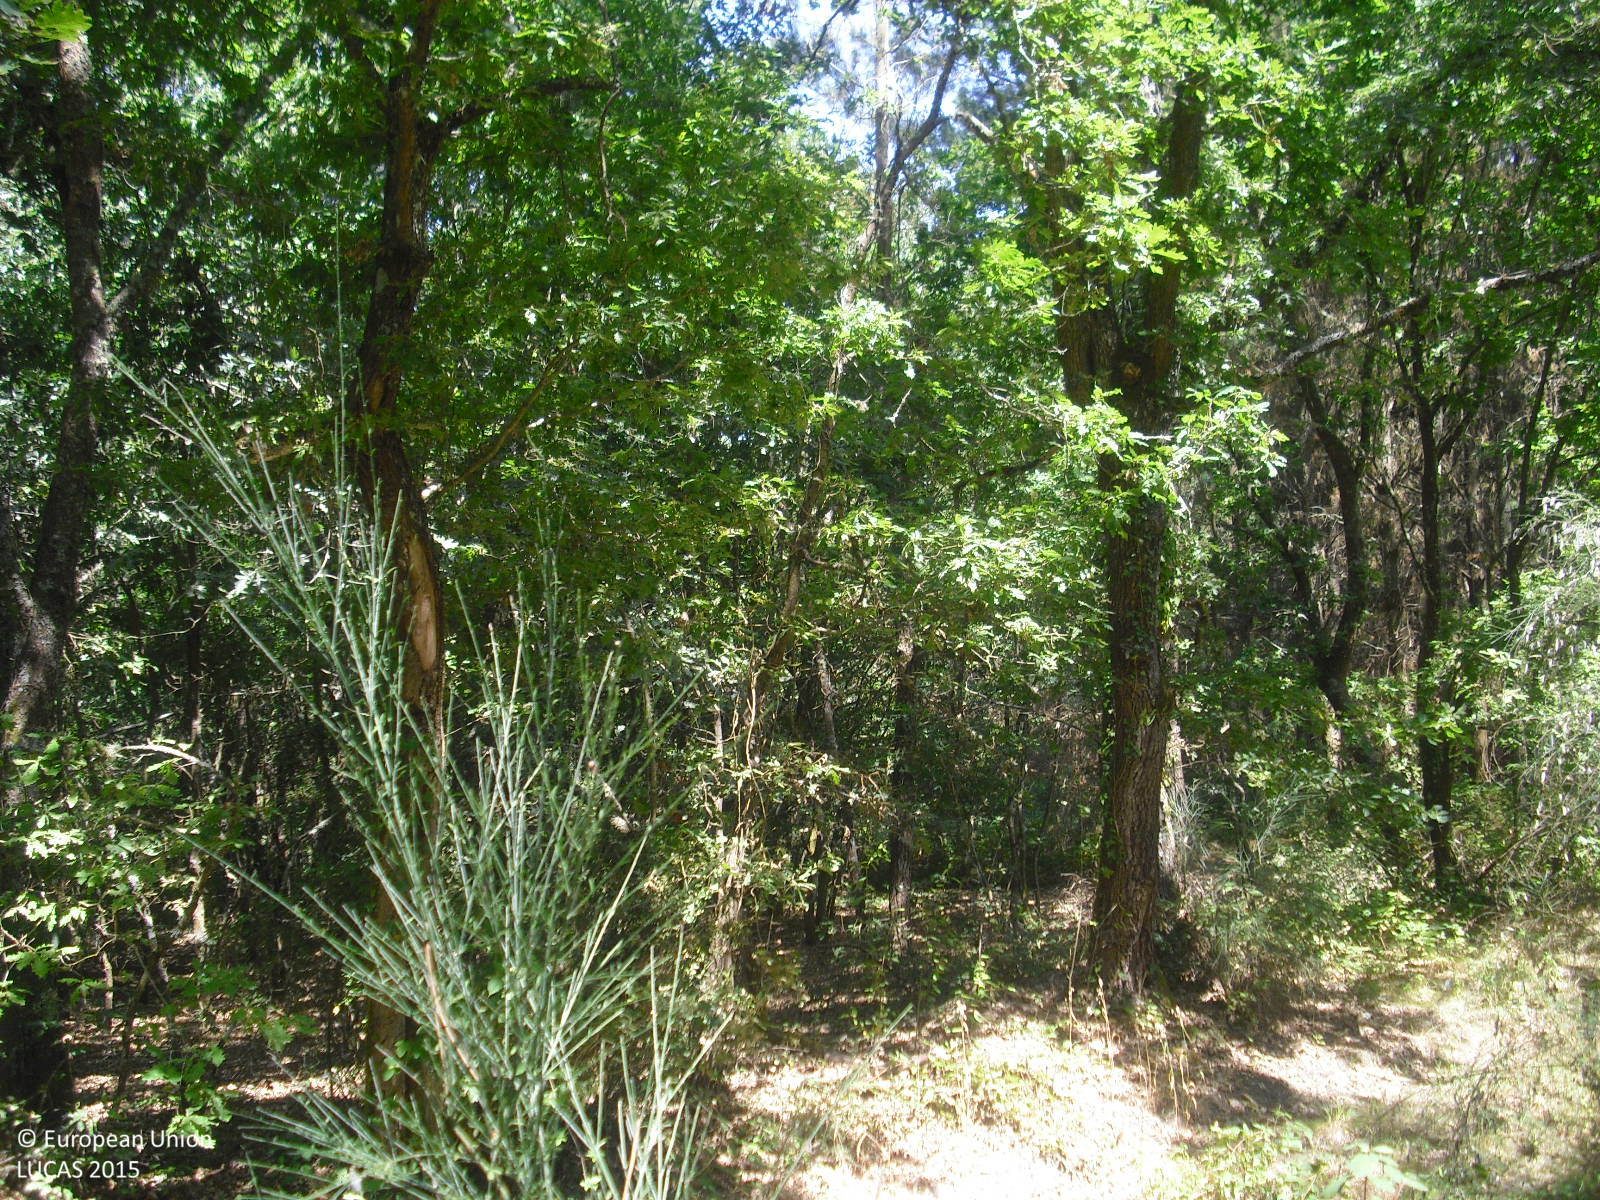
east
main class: Woodland
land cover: Pine dominated mixed woodland
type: hemiboreal forest and nemoral coniferous forest and mixed broadleaved-coniferous forest
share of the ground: 50 - 75 %
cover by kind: coniferous forest trees 45 %, broadleaved forest trees 35 %, shrubs 20 %
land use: Forestry
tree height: > 5 m
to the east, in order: Pine dominated mixed woodland; Tracks; Pine dominated mixed woodland; Shrubland with sparse tree cover; Grass margins; Tracks; Grass margins; Pine dominated coniferous woodland; Shruby margins; Ditches and canals; Grass margins; Paved roads, cycling and walking lanes; Grass margins; Fences; Grassland without tree/shrub cover; Fences; Spontaneously vegetated surfaces; Shruby margins; Fences; Grassland without tree/shrub cover
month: July
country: ES
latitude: 42.5063
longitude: -7.4587
